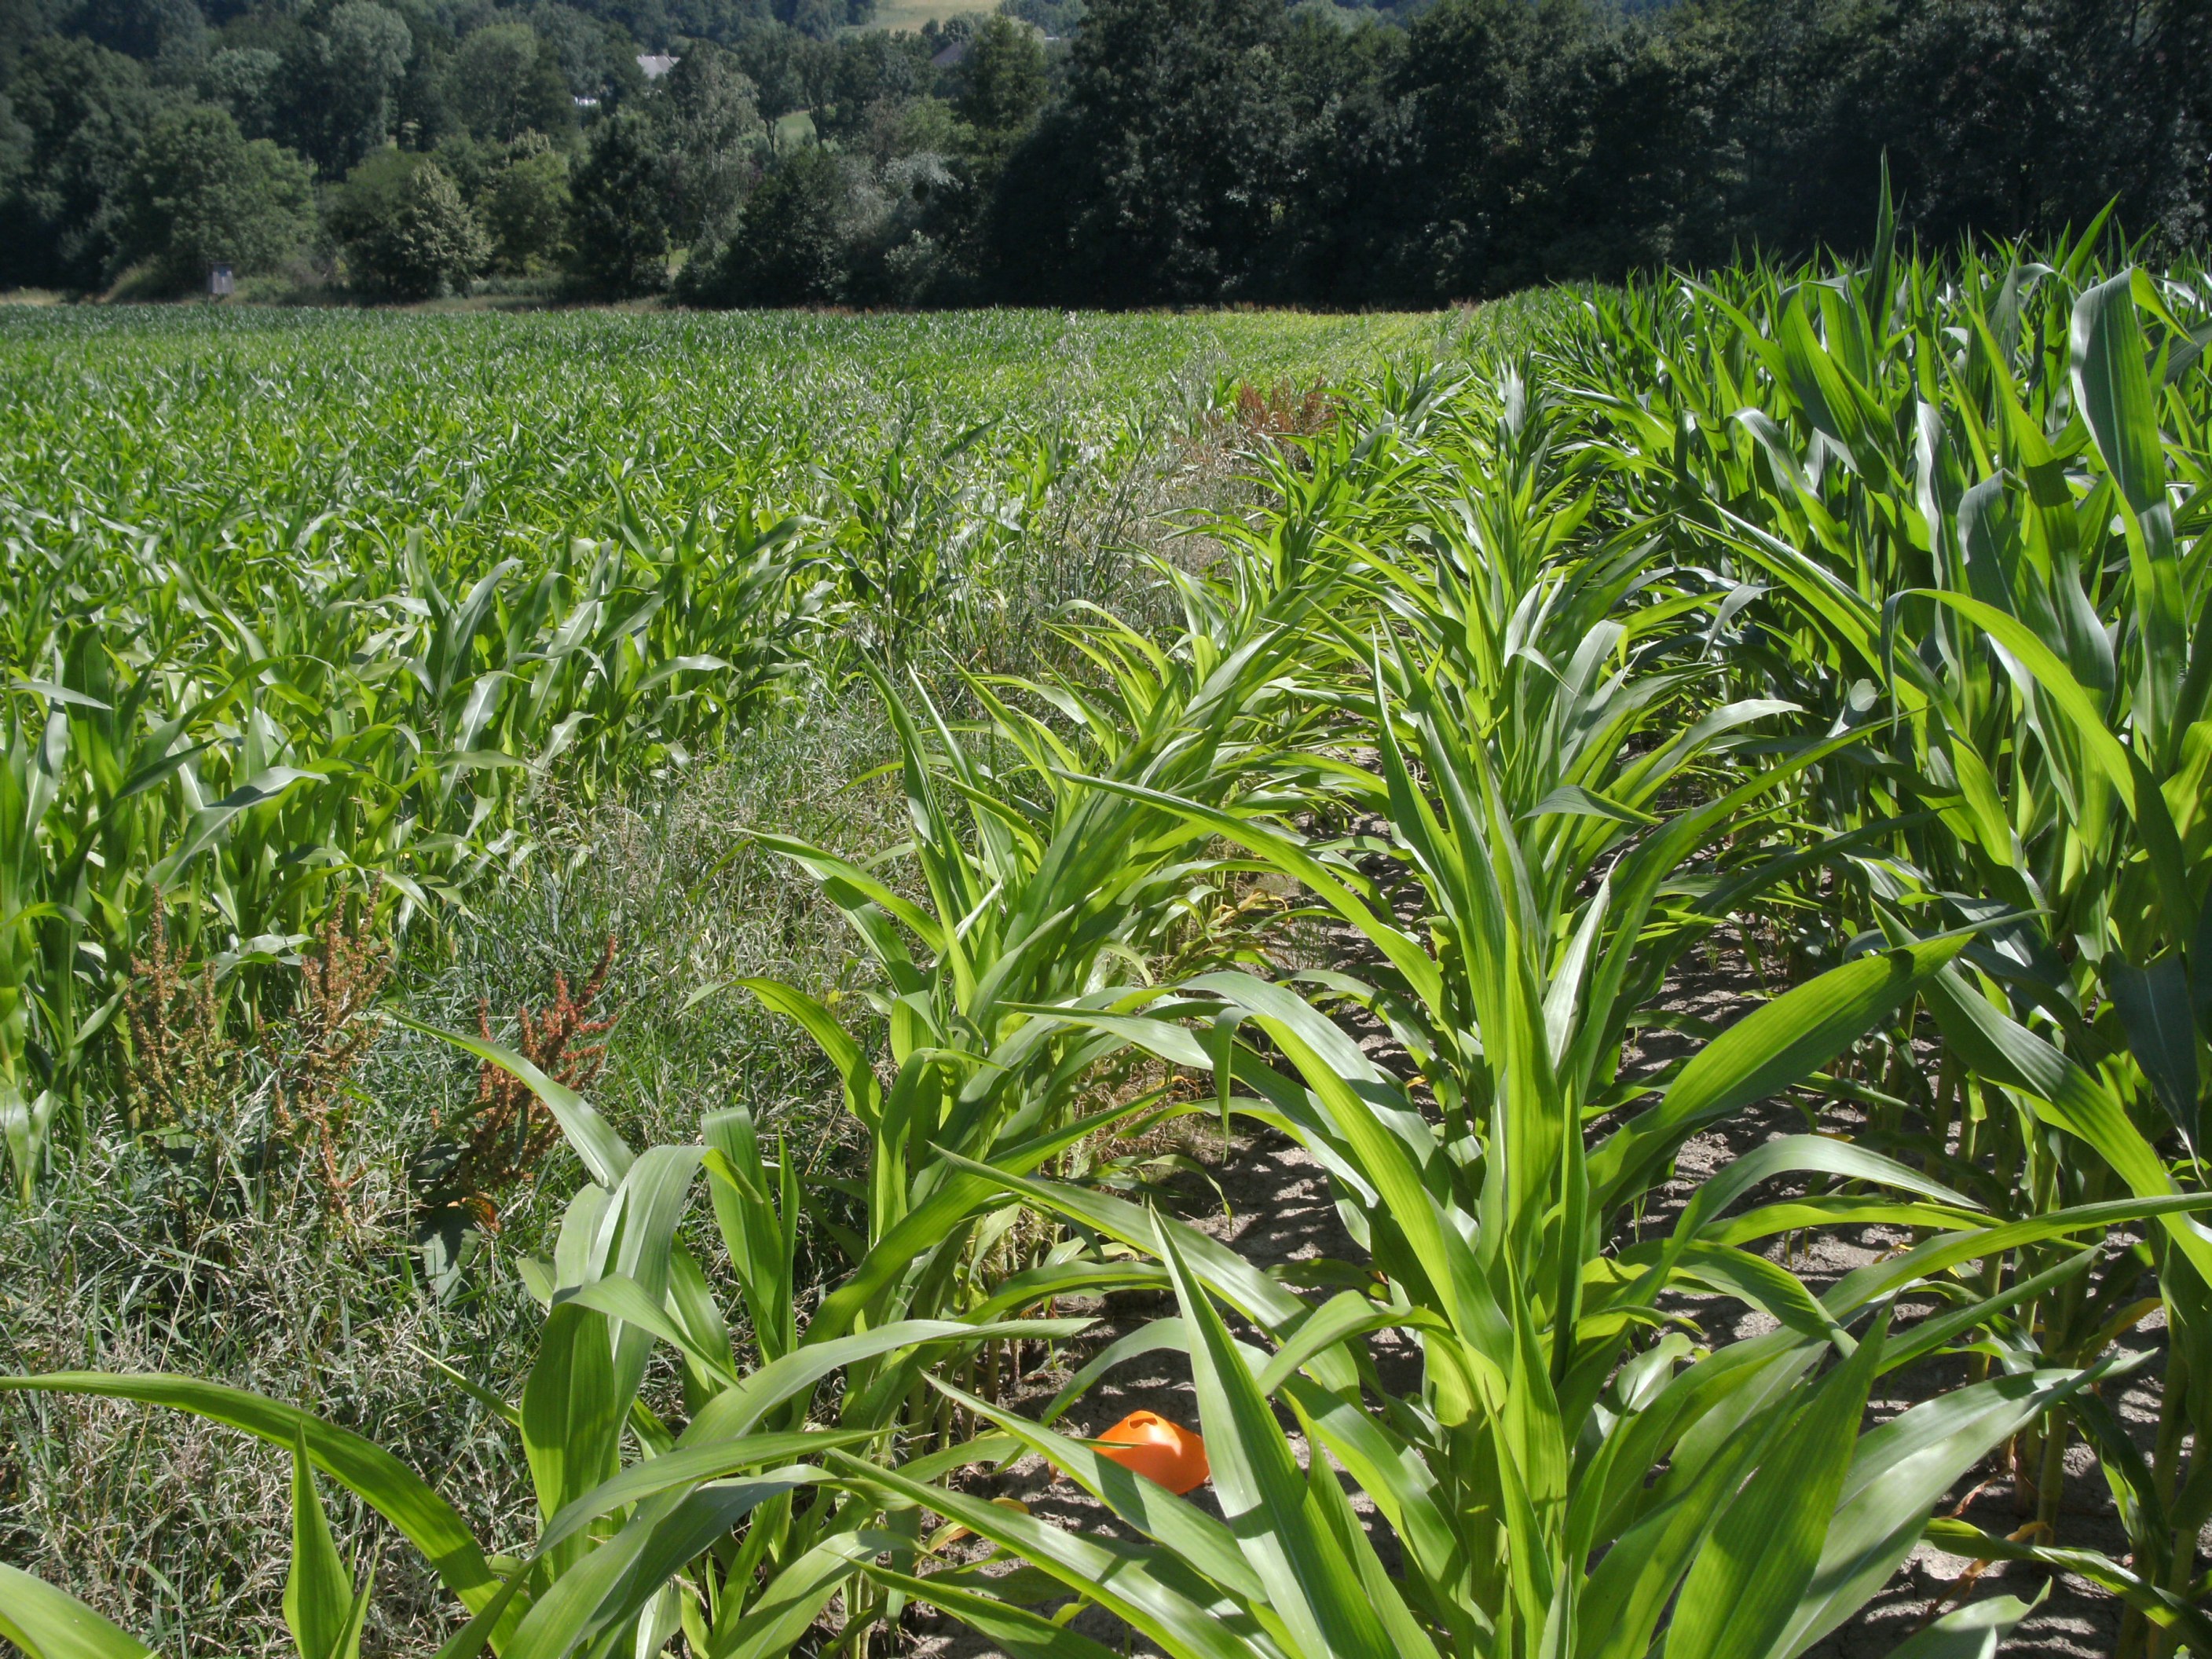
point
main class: Cropland
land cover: Maize
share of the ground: 50 - 75 %
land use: Agriculture (excluding fallow land and kitchen gardens)
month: July
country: AT
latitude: 48.2581
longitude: 14.0272
